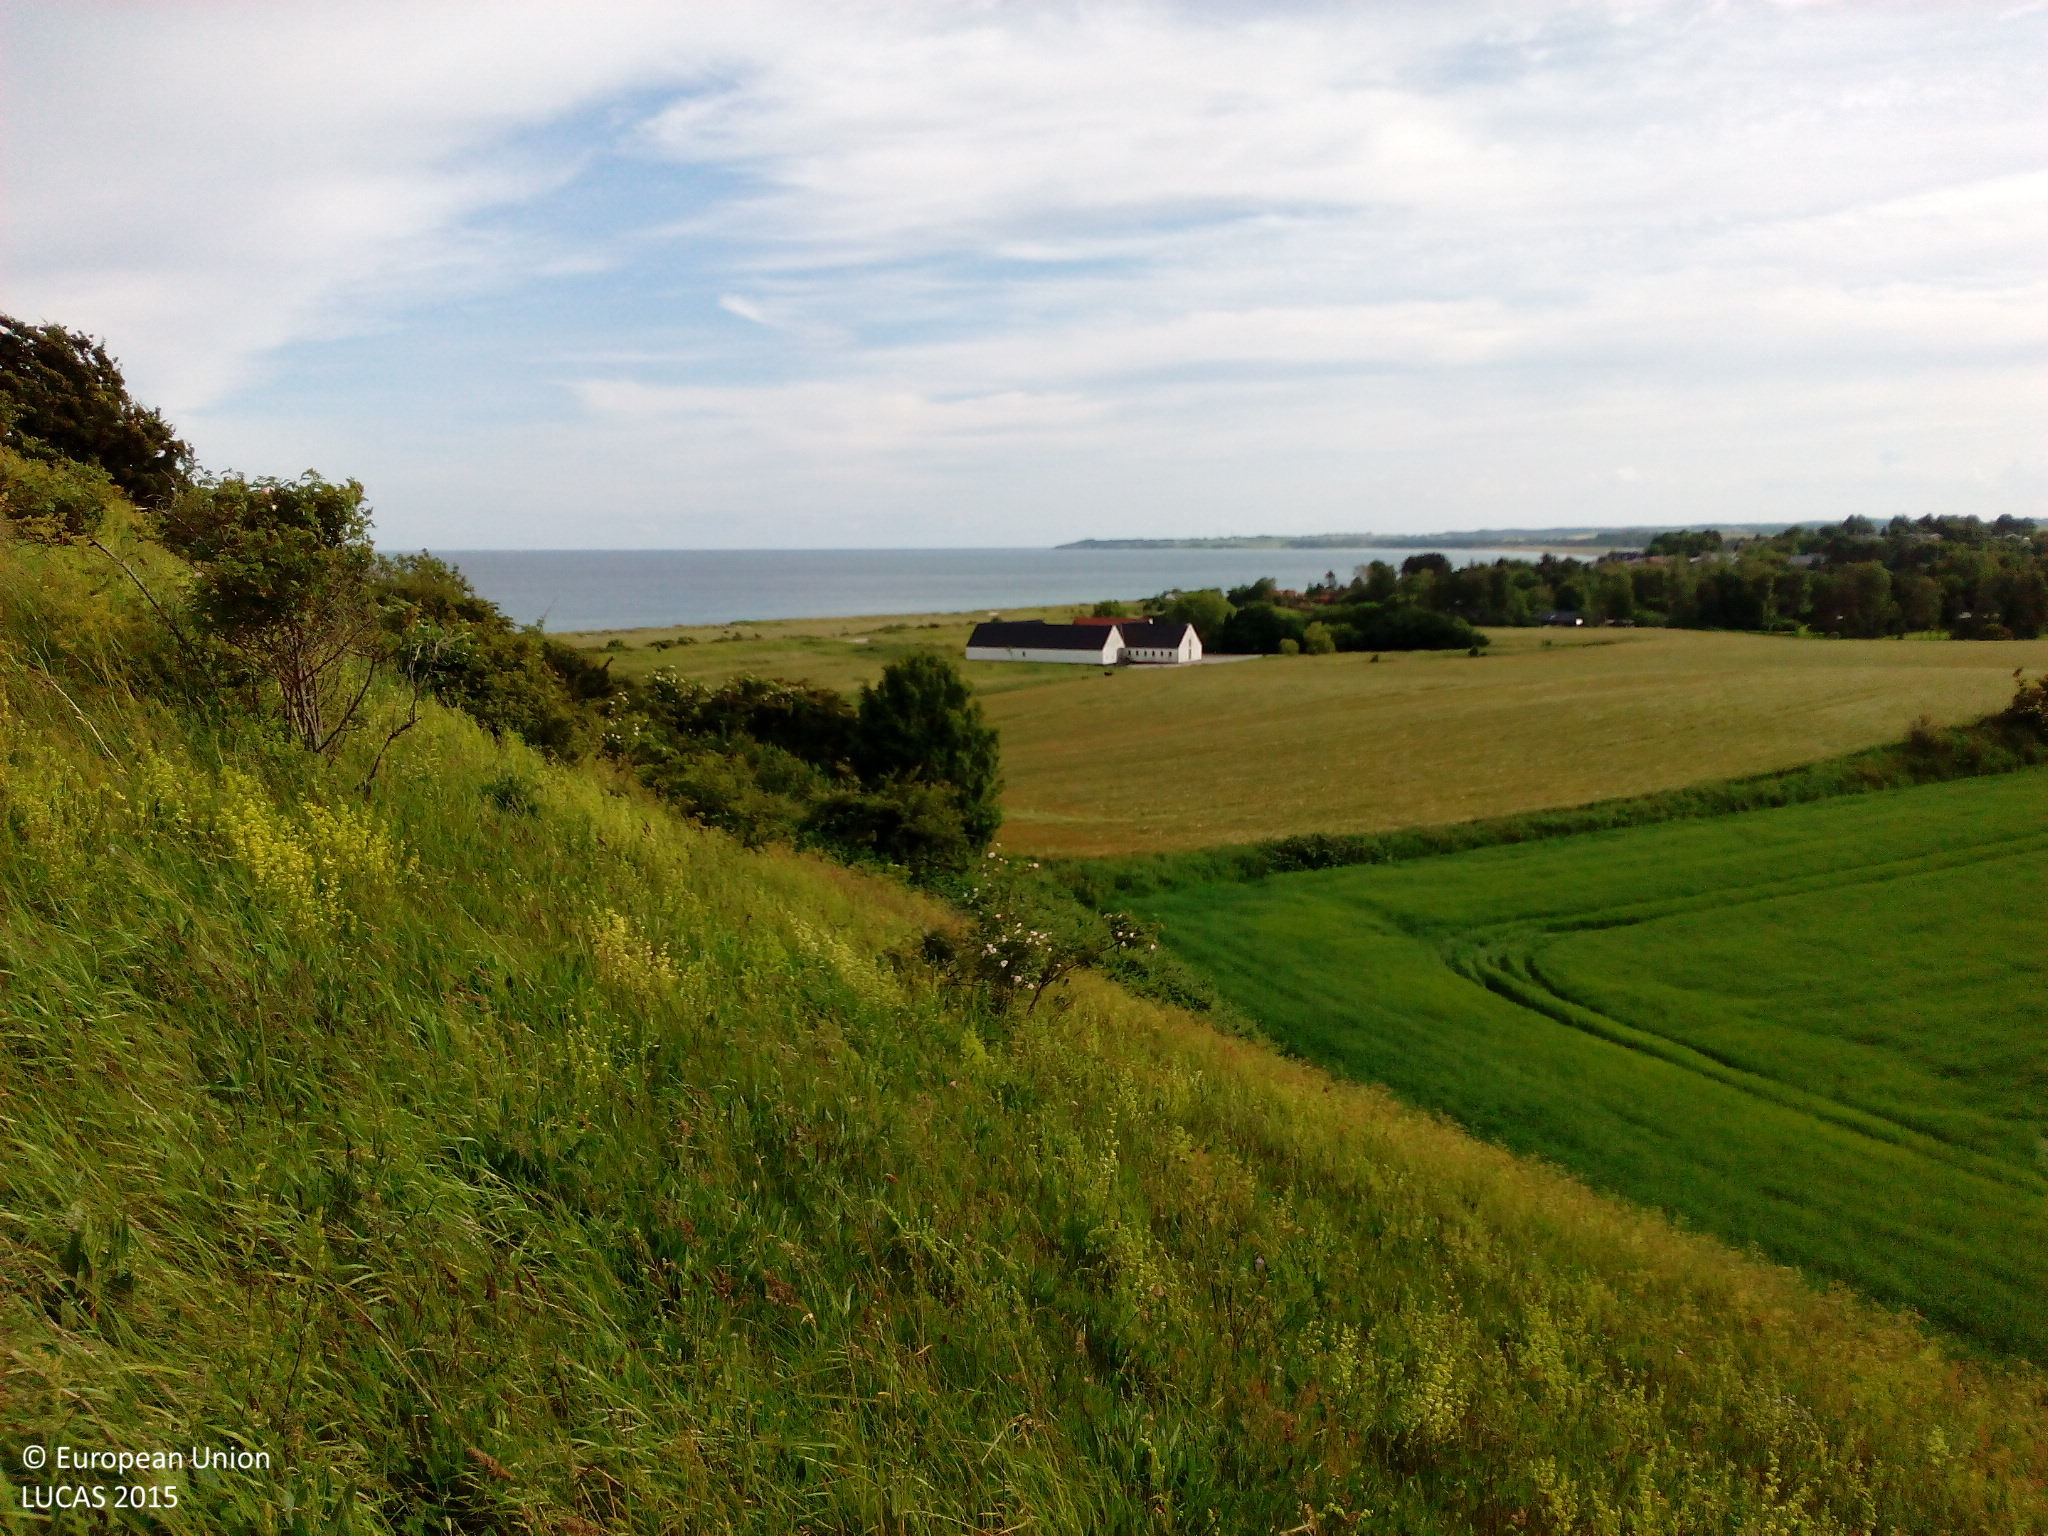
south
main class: Grassland
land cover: Grassland without tree/shrub cover
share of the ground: > 75 %
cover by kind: herbaceous plants 100 %
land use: Semi-natural and natural areas not in use
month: June
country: DK
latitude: 56.2394
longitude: 10.7574
